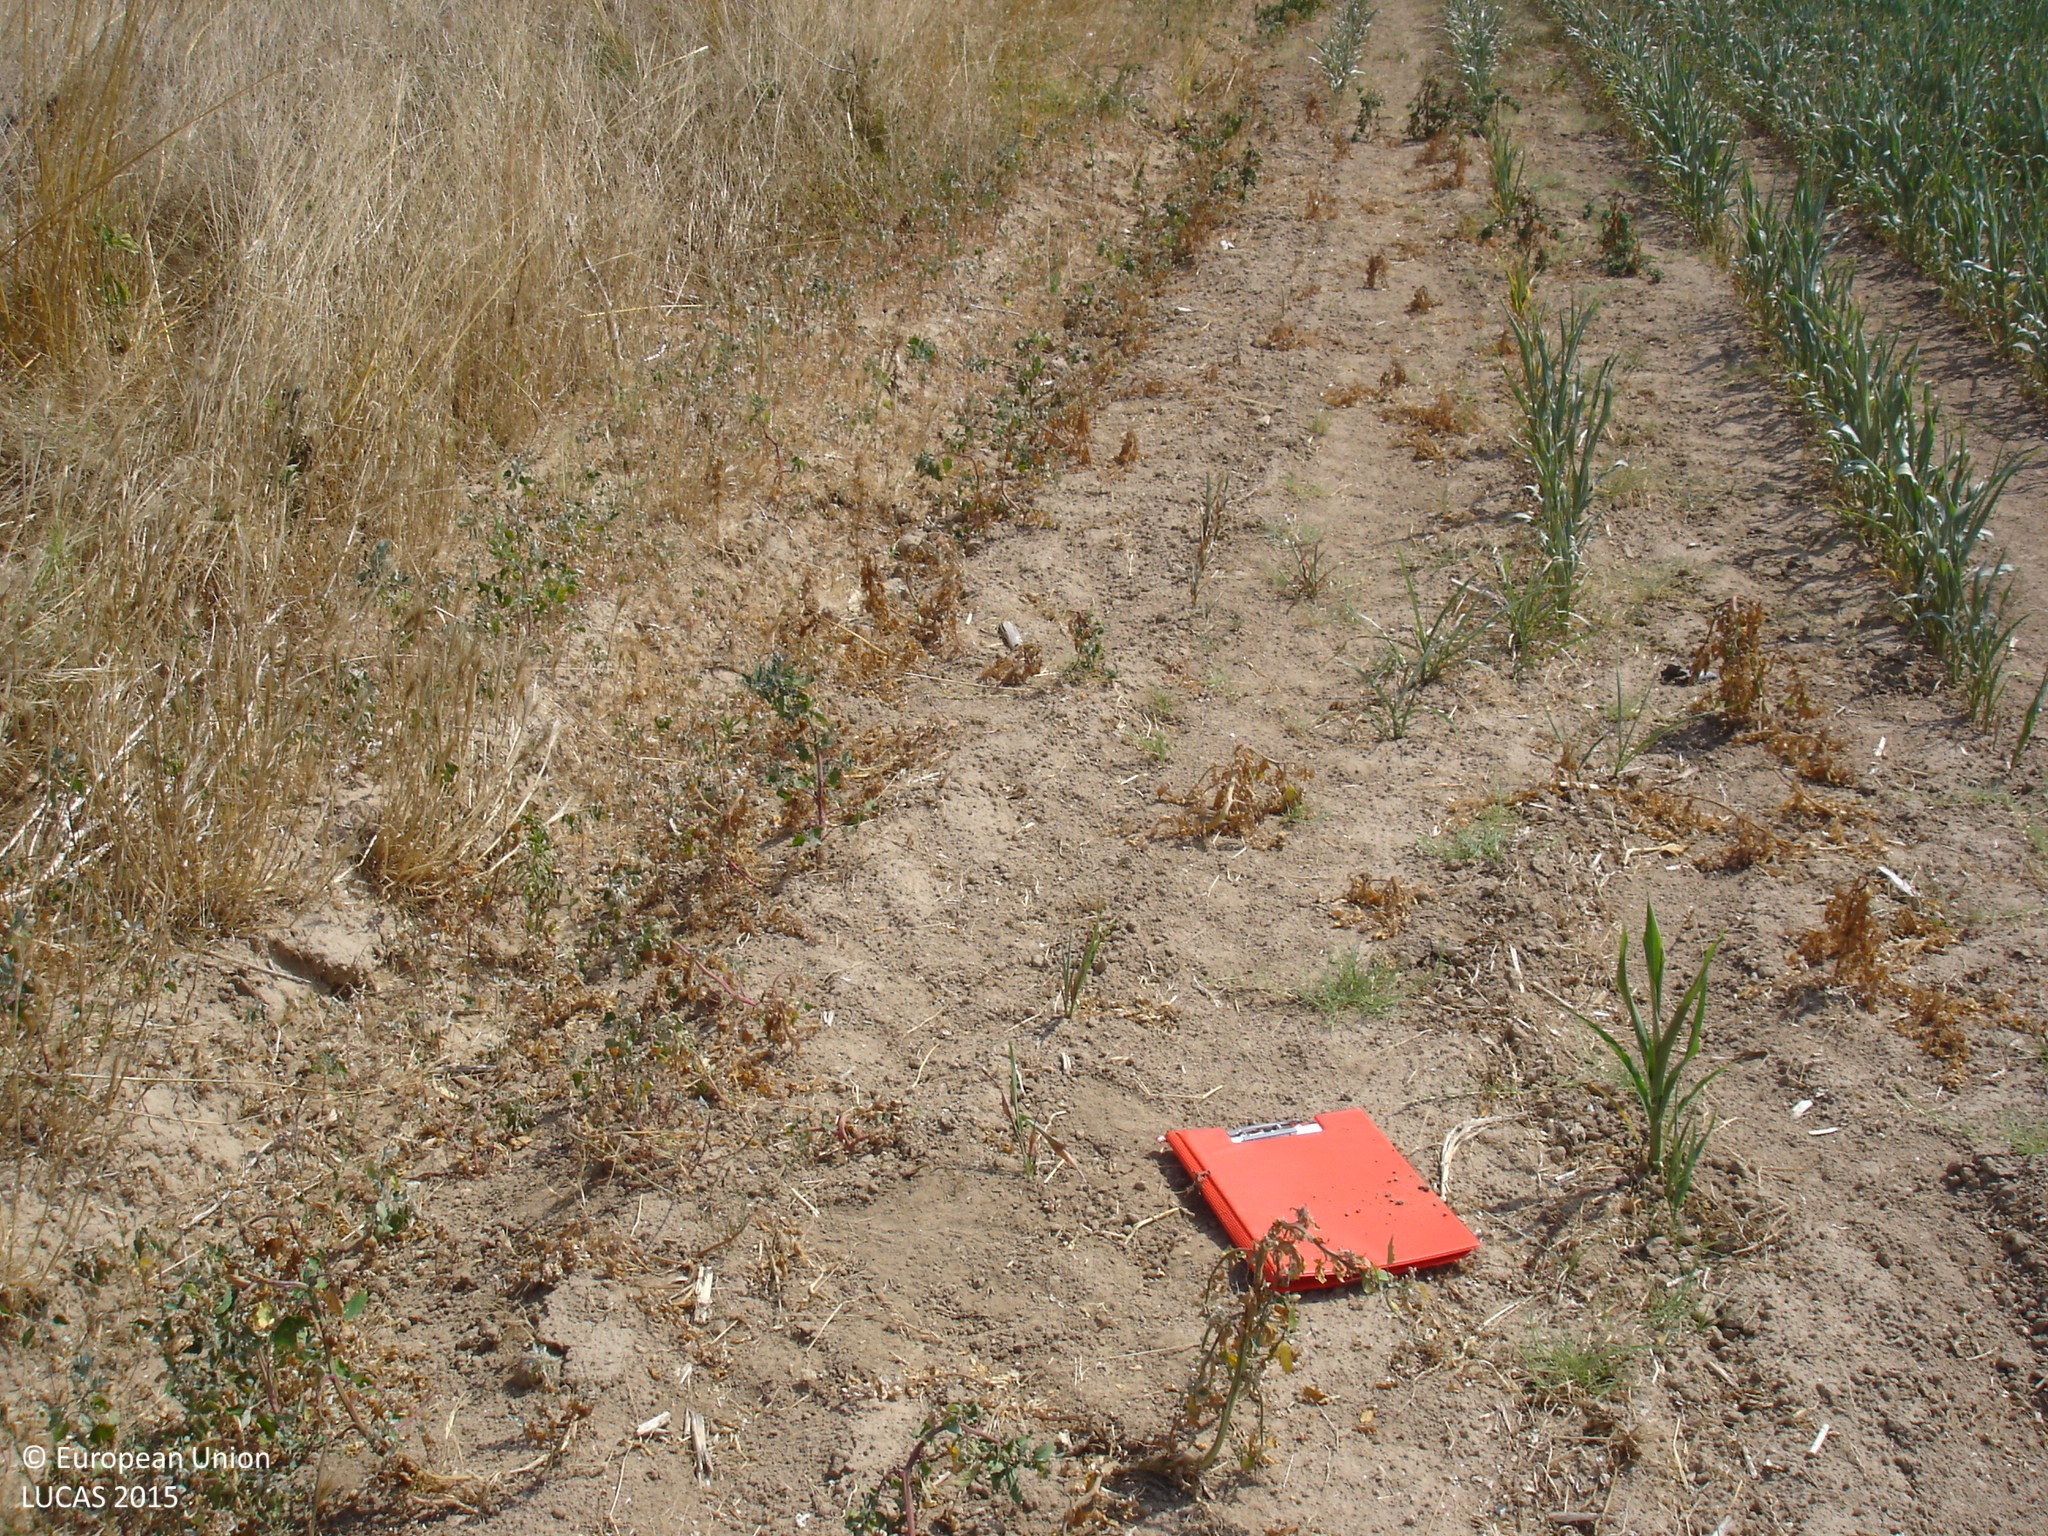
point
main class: Cropland
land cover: Maize
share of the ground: 10 - 25 %
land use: Agriculture (excluding fallow land and kitchen gardens)
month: July
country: ES
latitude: 42.0506
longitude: 3.0197
